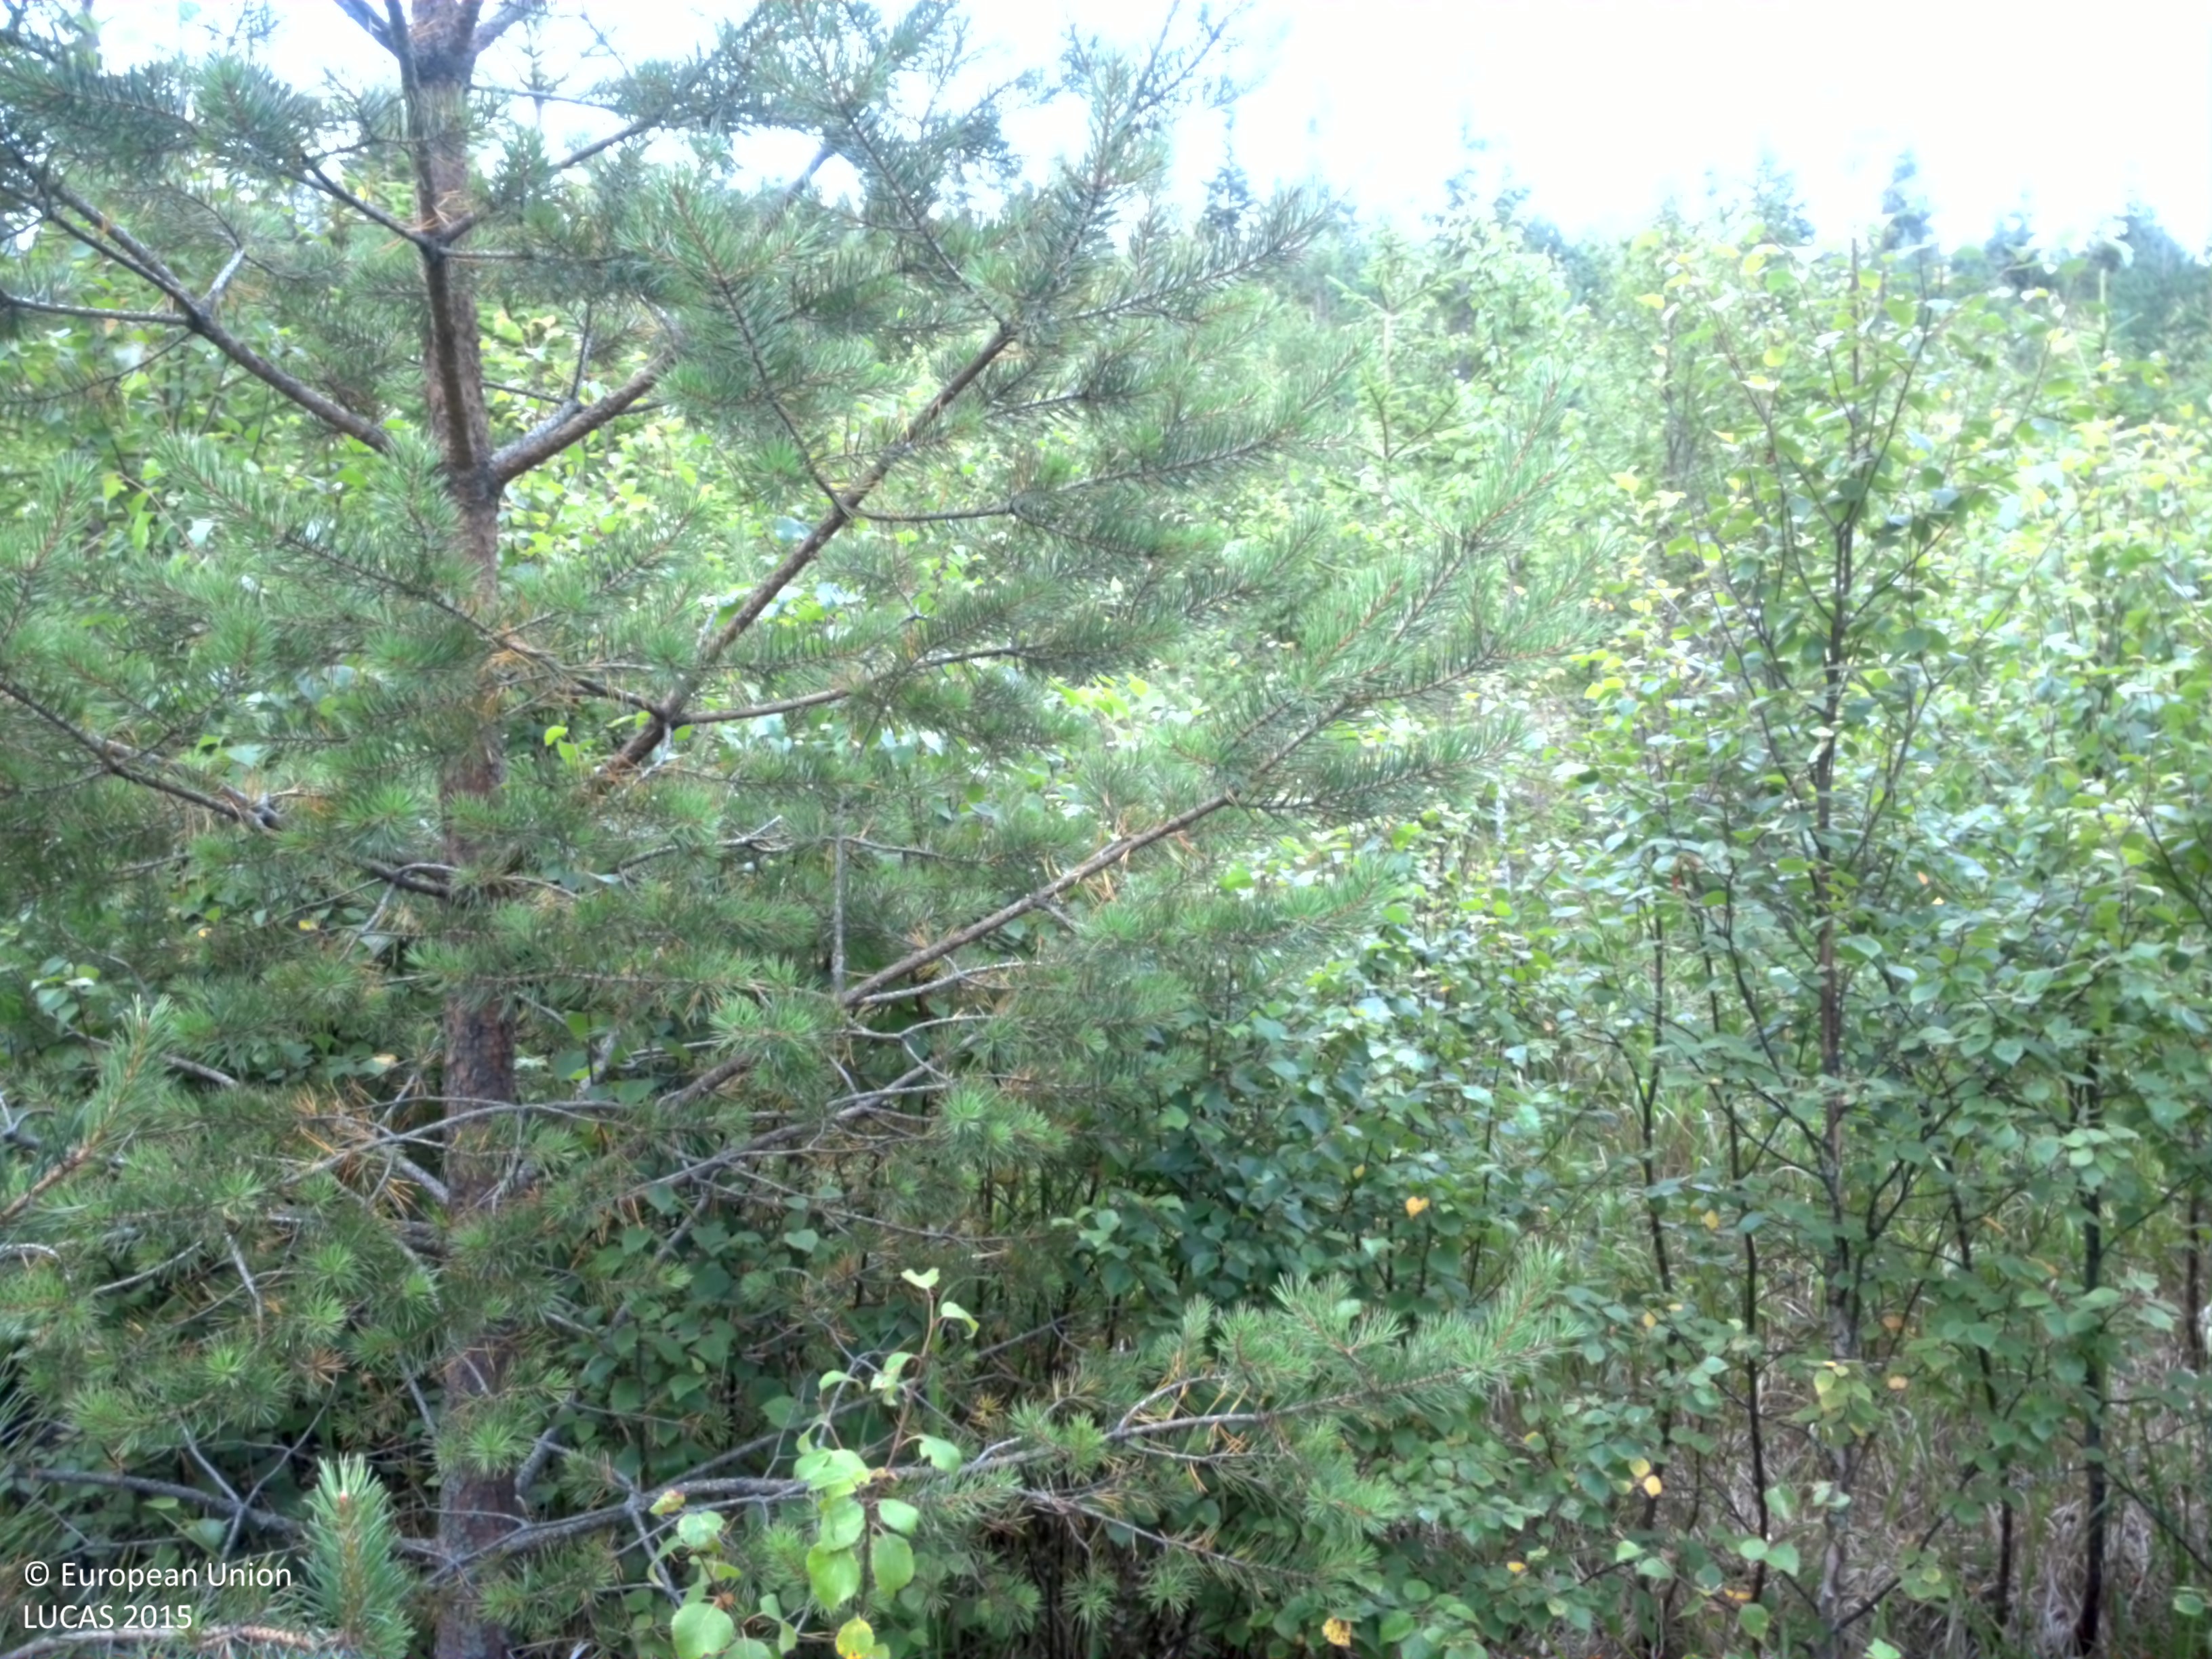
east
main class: Woodland
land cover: Spruce dominated mixed woodland
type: boreal forest
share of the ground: > 75 %
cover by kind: broadleaved forest trees 45 %, coniferous forest trees 35 %, shrubs 10 %, herbaceous plants 10 %
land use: Forestry
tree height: < 5 m
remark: Clear cut
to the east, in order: Spruce dominated mixed woodland; Pine dominated mixed woodland; Pine dominated coniferous woodland
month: August
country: SE
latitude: 60.1567
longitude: 14.1151
